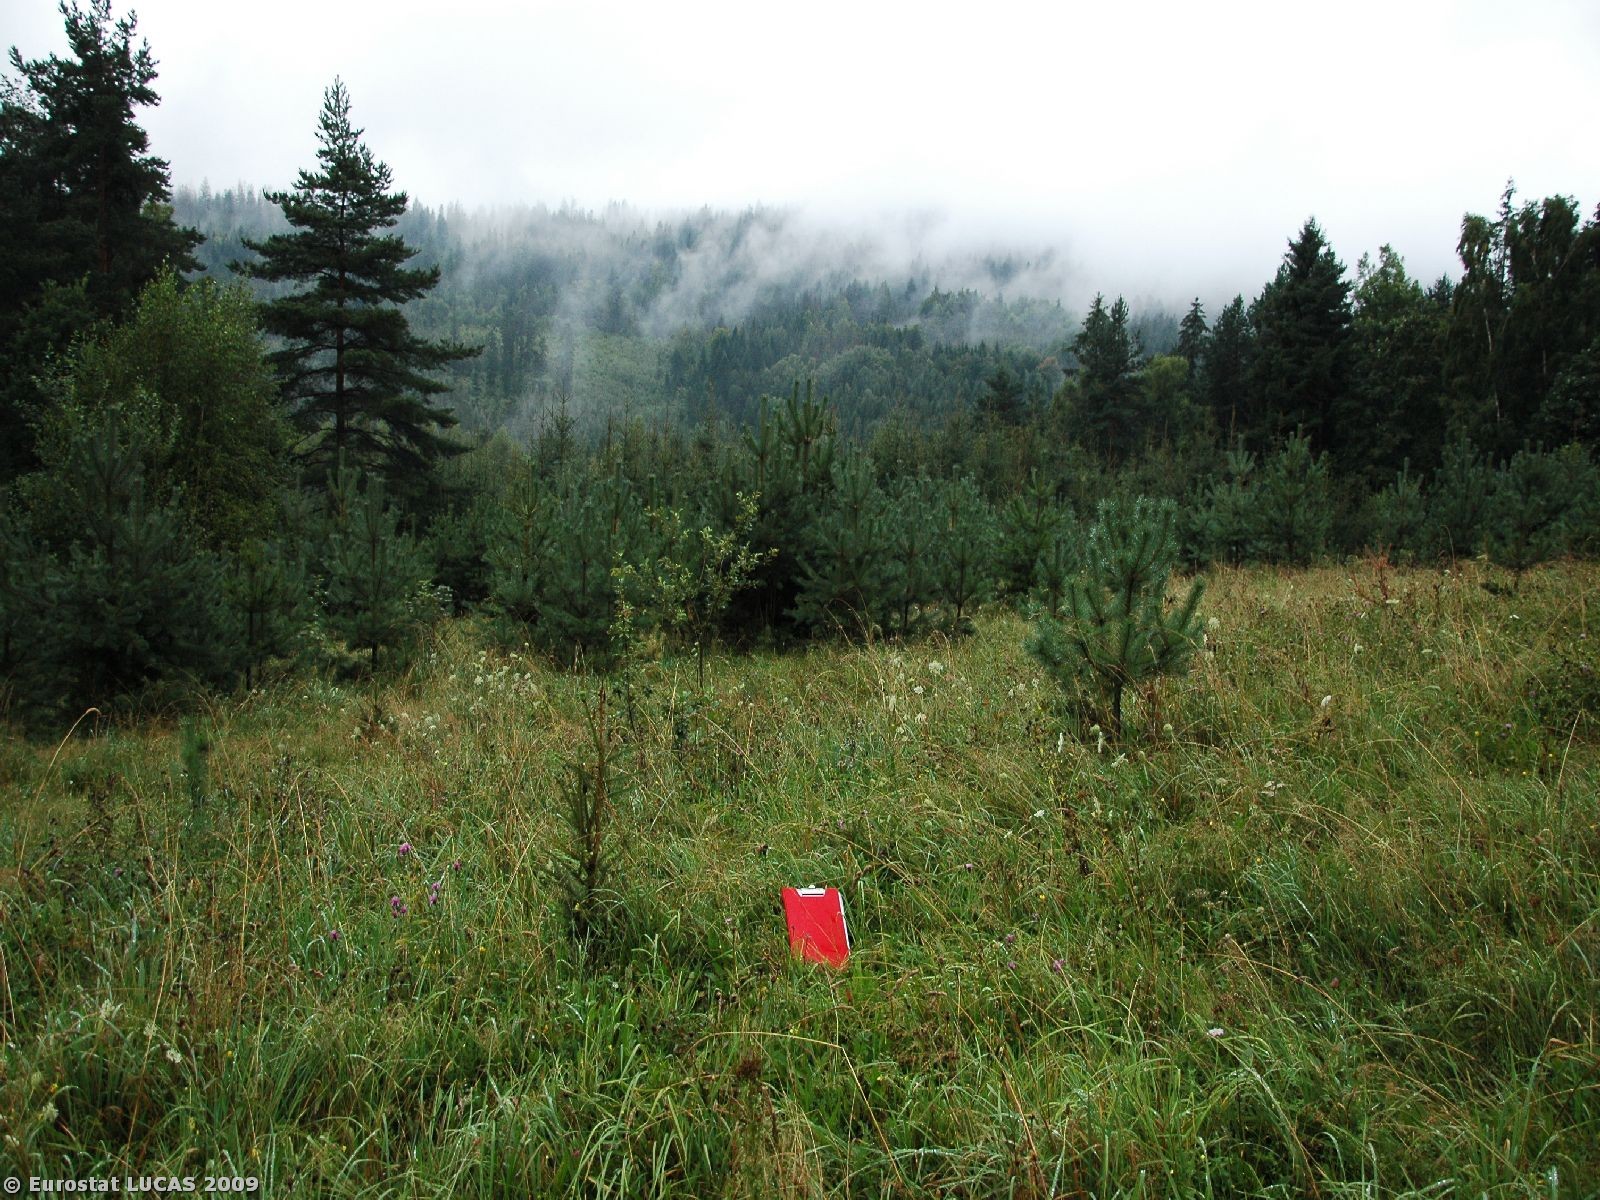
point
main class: Grassland
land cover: Grassland with sparse tree/shrub cover
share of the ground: > 75 %
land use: Unused
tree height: > 5 m
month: August
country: PL
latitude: 49.5523
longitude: 19.0491
